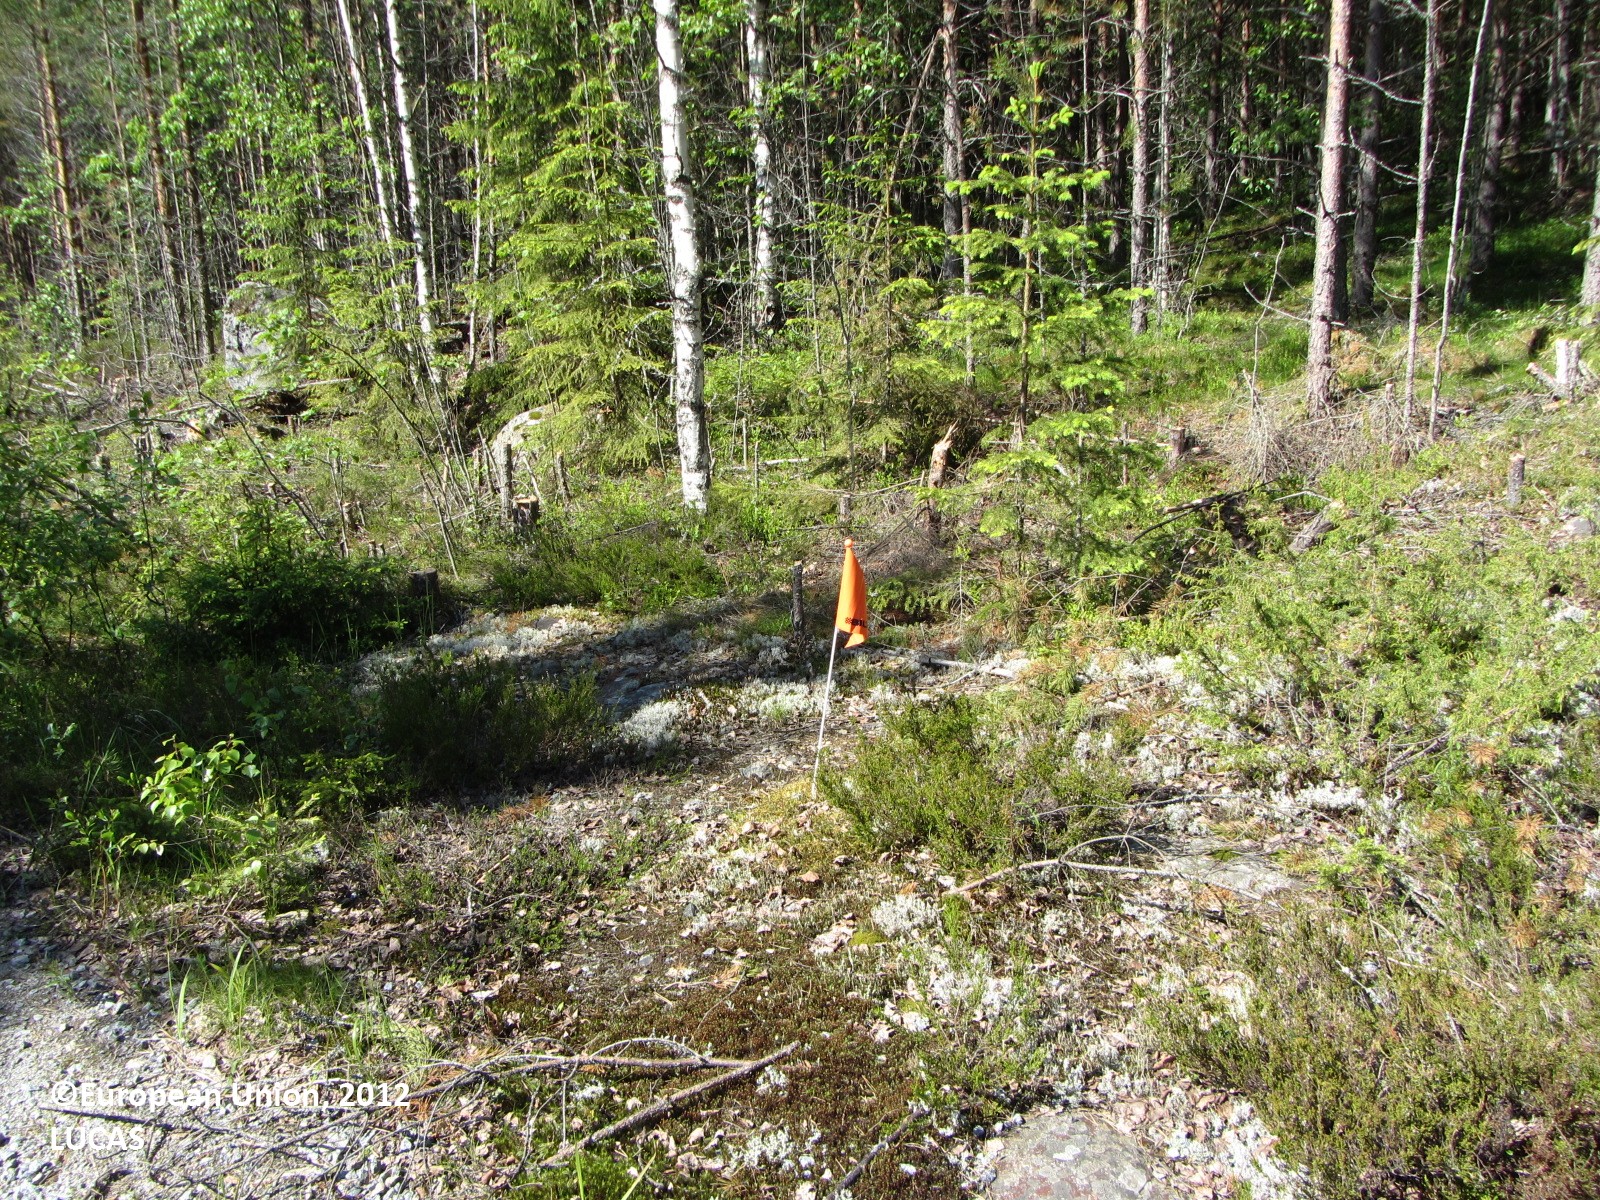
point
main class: Woodland
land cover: Other mixed woodland
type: boreal forest
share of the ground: > 75 %
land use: Forestry
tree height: > 5 m
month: June
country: FI
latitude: 62.3112
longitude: 24.8564
